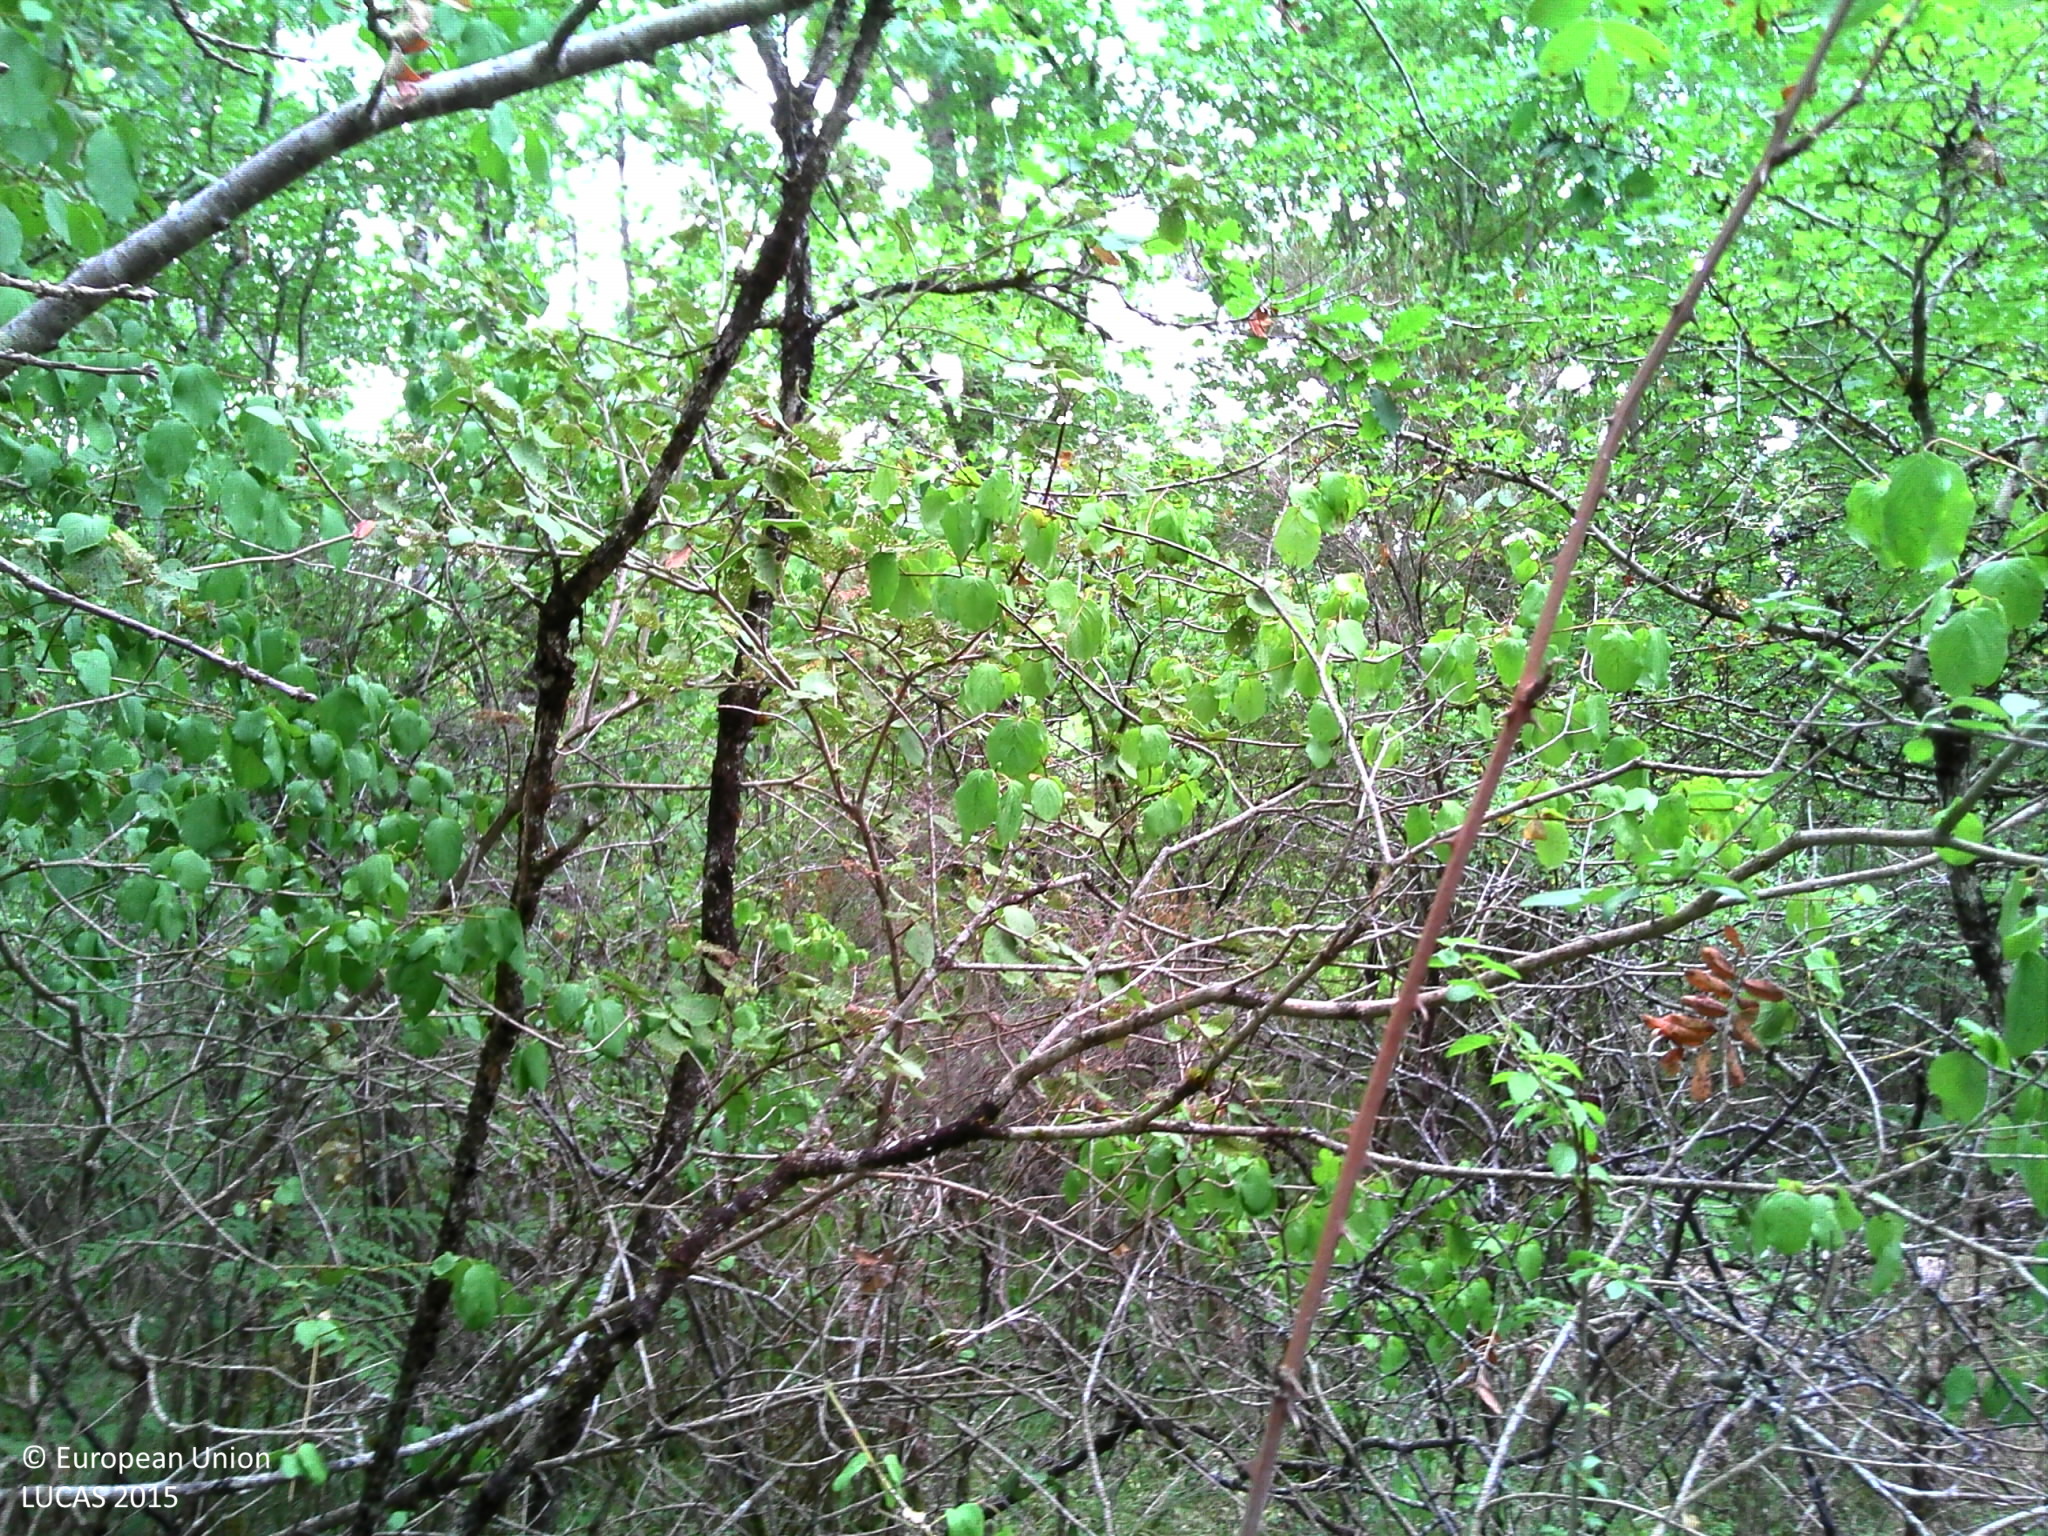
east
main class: Woodland
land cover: Broadleaved woodland
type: acidophilous oak and oak-birch forest
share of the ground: > 75 %
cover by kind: broadleaved forest trees 75 %, shrubs 10 %, herbaceous plants 10 %, lichens and mosses 5 %
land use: Forestry
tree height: > 5 m
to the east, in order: Broadleaved woodland; Grass margins; Paved roads, cycling and walking lanes; Grass margins; Broadleaved woodland; Tracks; Broadleaved woodland; Grassland without tree/shrub cover; Broadleaved woodland
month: July
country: FR
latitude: 45.0254
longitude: 1.1733
